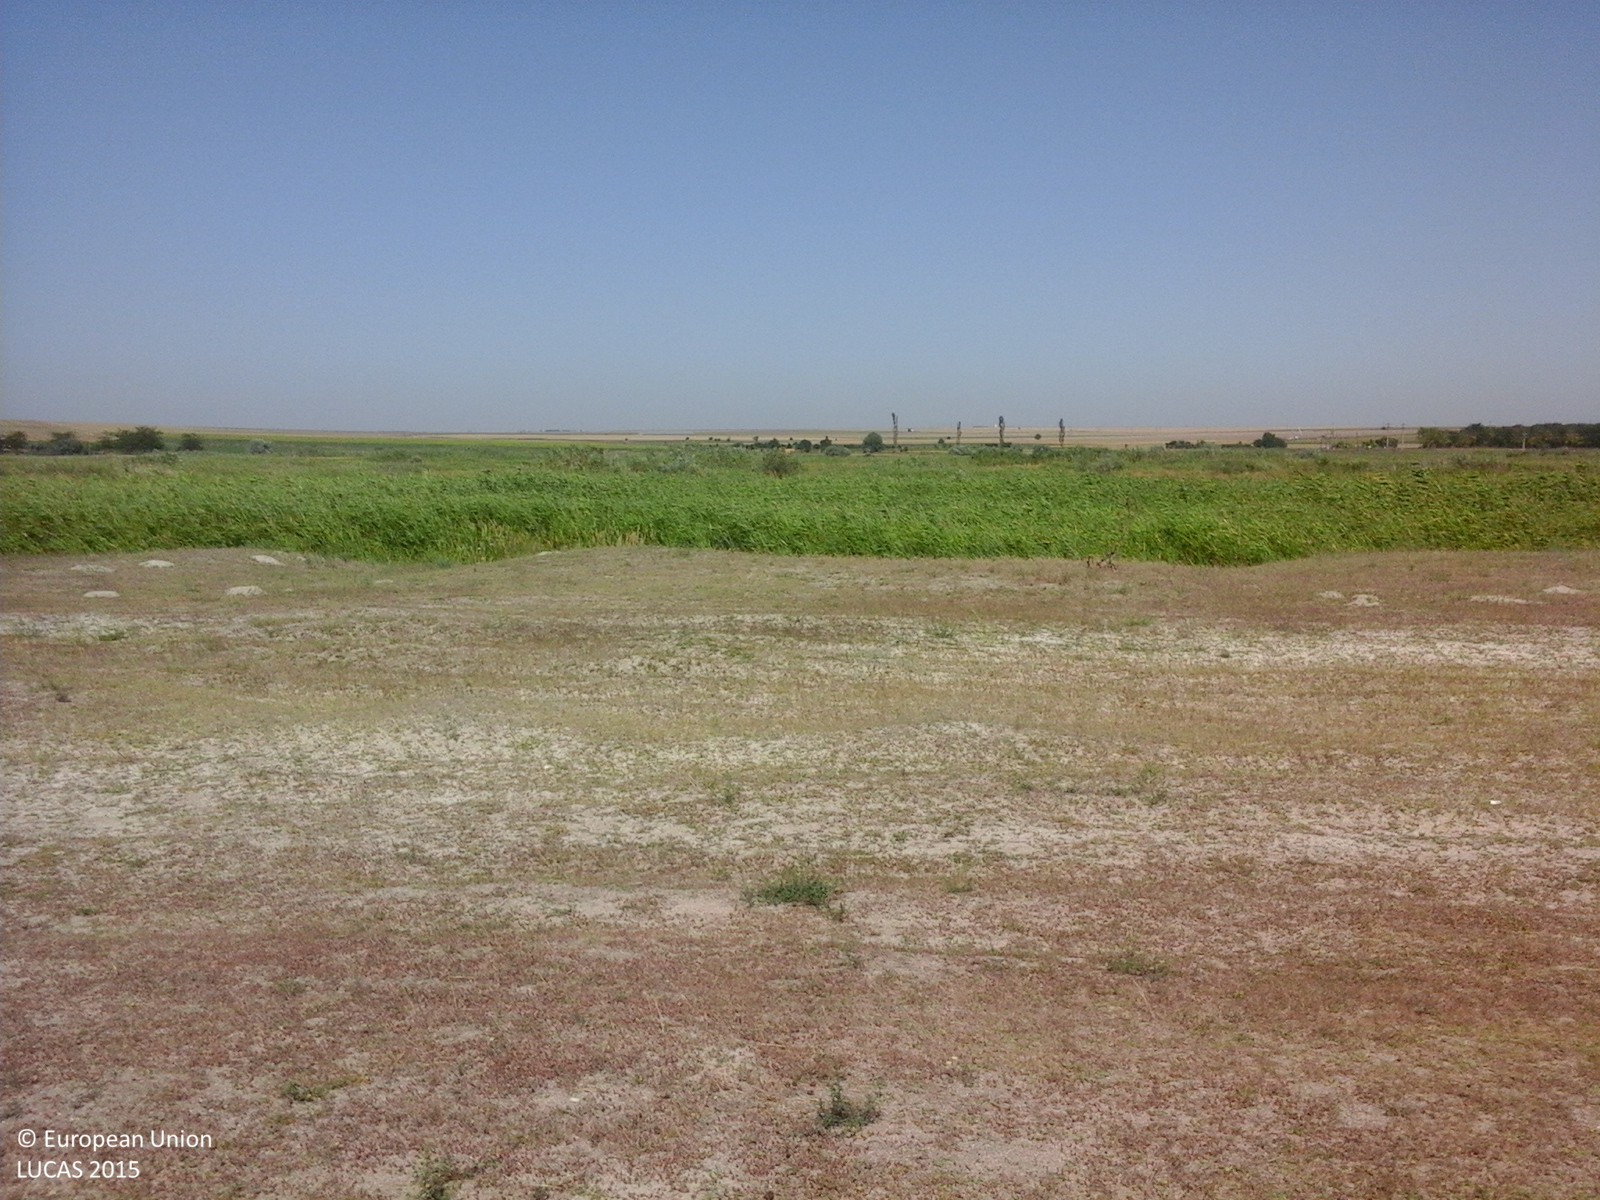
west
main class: Grassland
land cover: Grassland without tree/shrub cover
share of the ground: < 10 %
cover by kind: unconsolidated bare surface 80 %, herbaceous plants 20 %
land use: Agriculture (excluding fallow land and kitchen gardens)
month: August
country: RO
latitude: 44.4358
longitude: 28.7366
